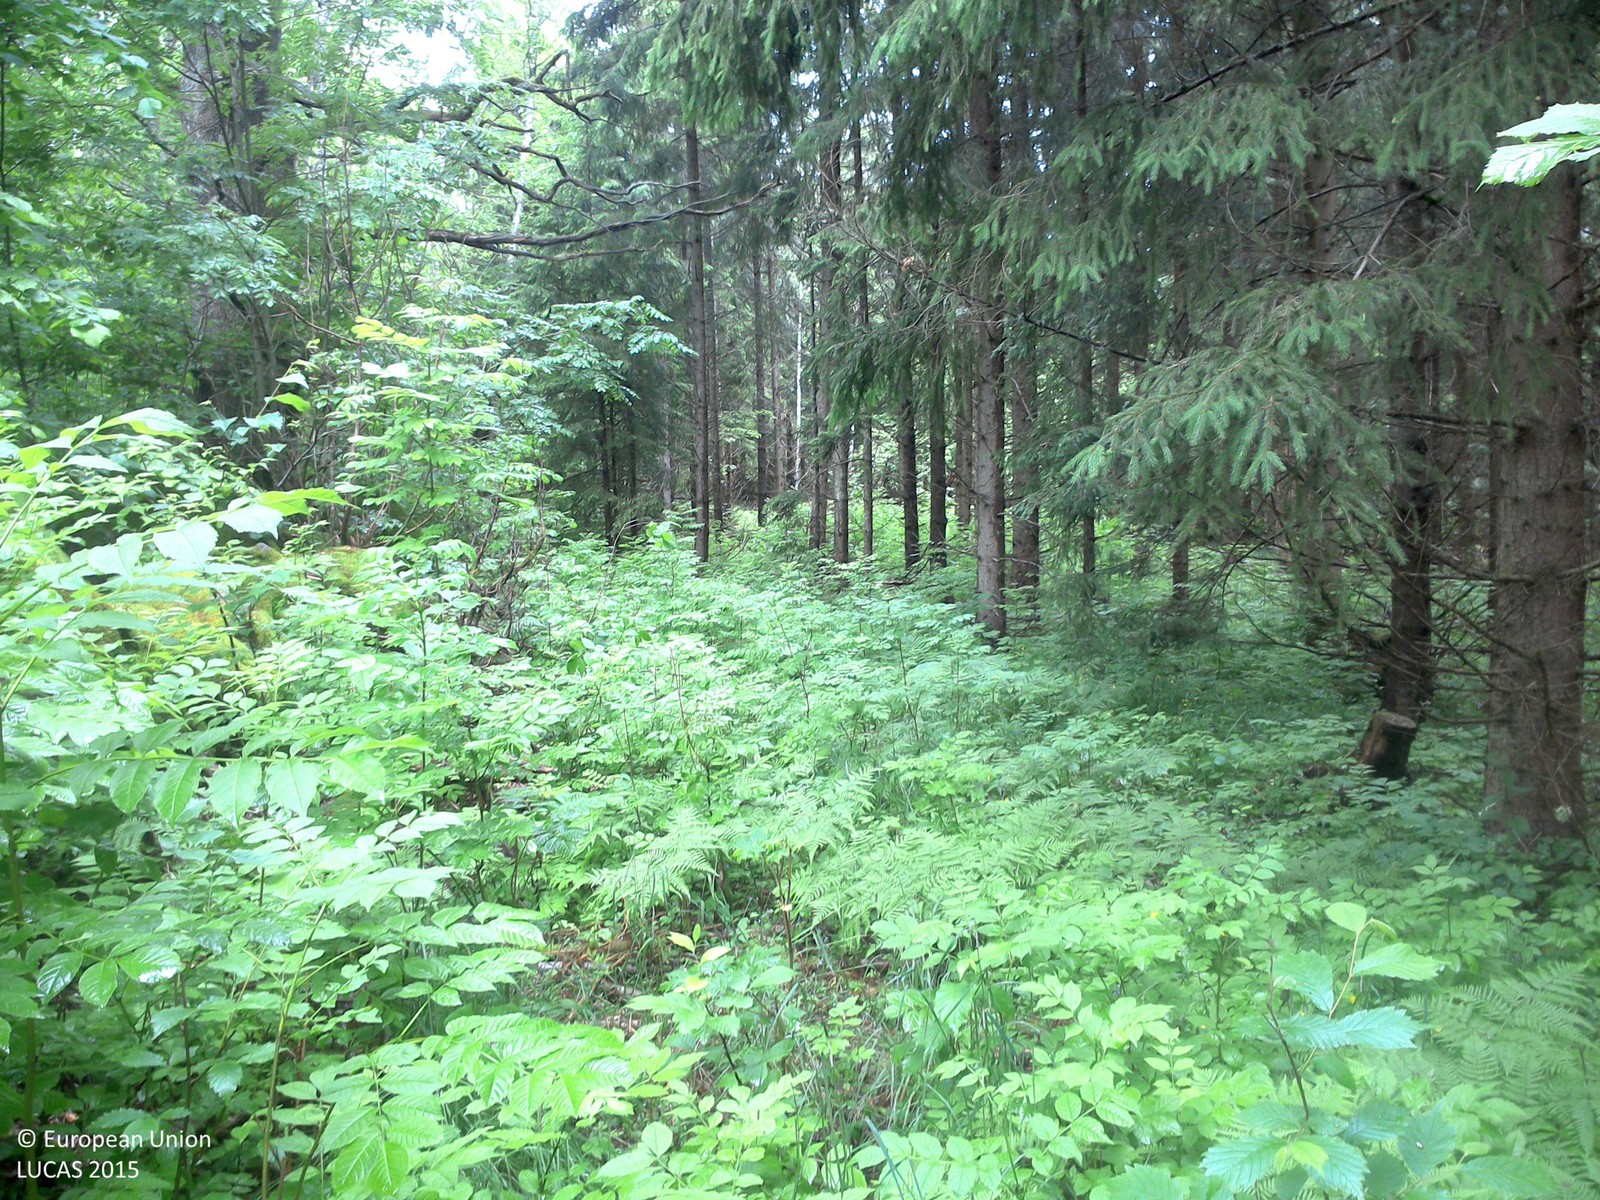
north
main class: Woodland
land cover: Broadleaved woodland
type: boreal forest
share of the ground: > 75 %
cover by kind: broadleaved forest trees 75 %, herbaceous plants 25 %
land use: Forestry
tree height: > 5 m
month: June
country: SE
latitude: 58.0665
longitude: 15.6062
